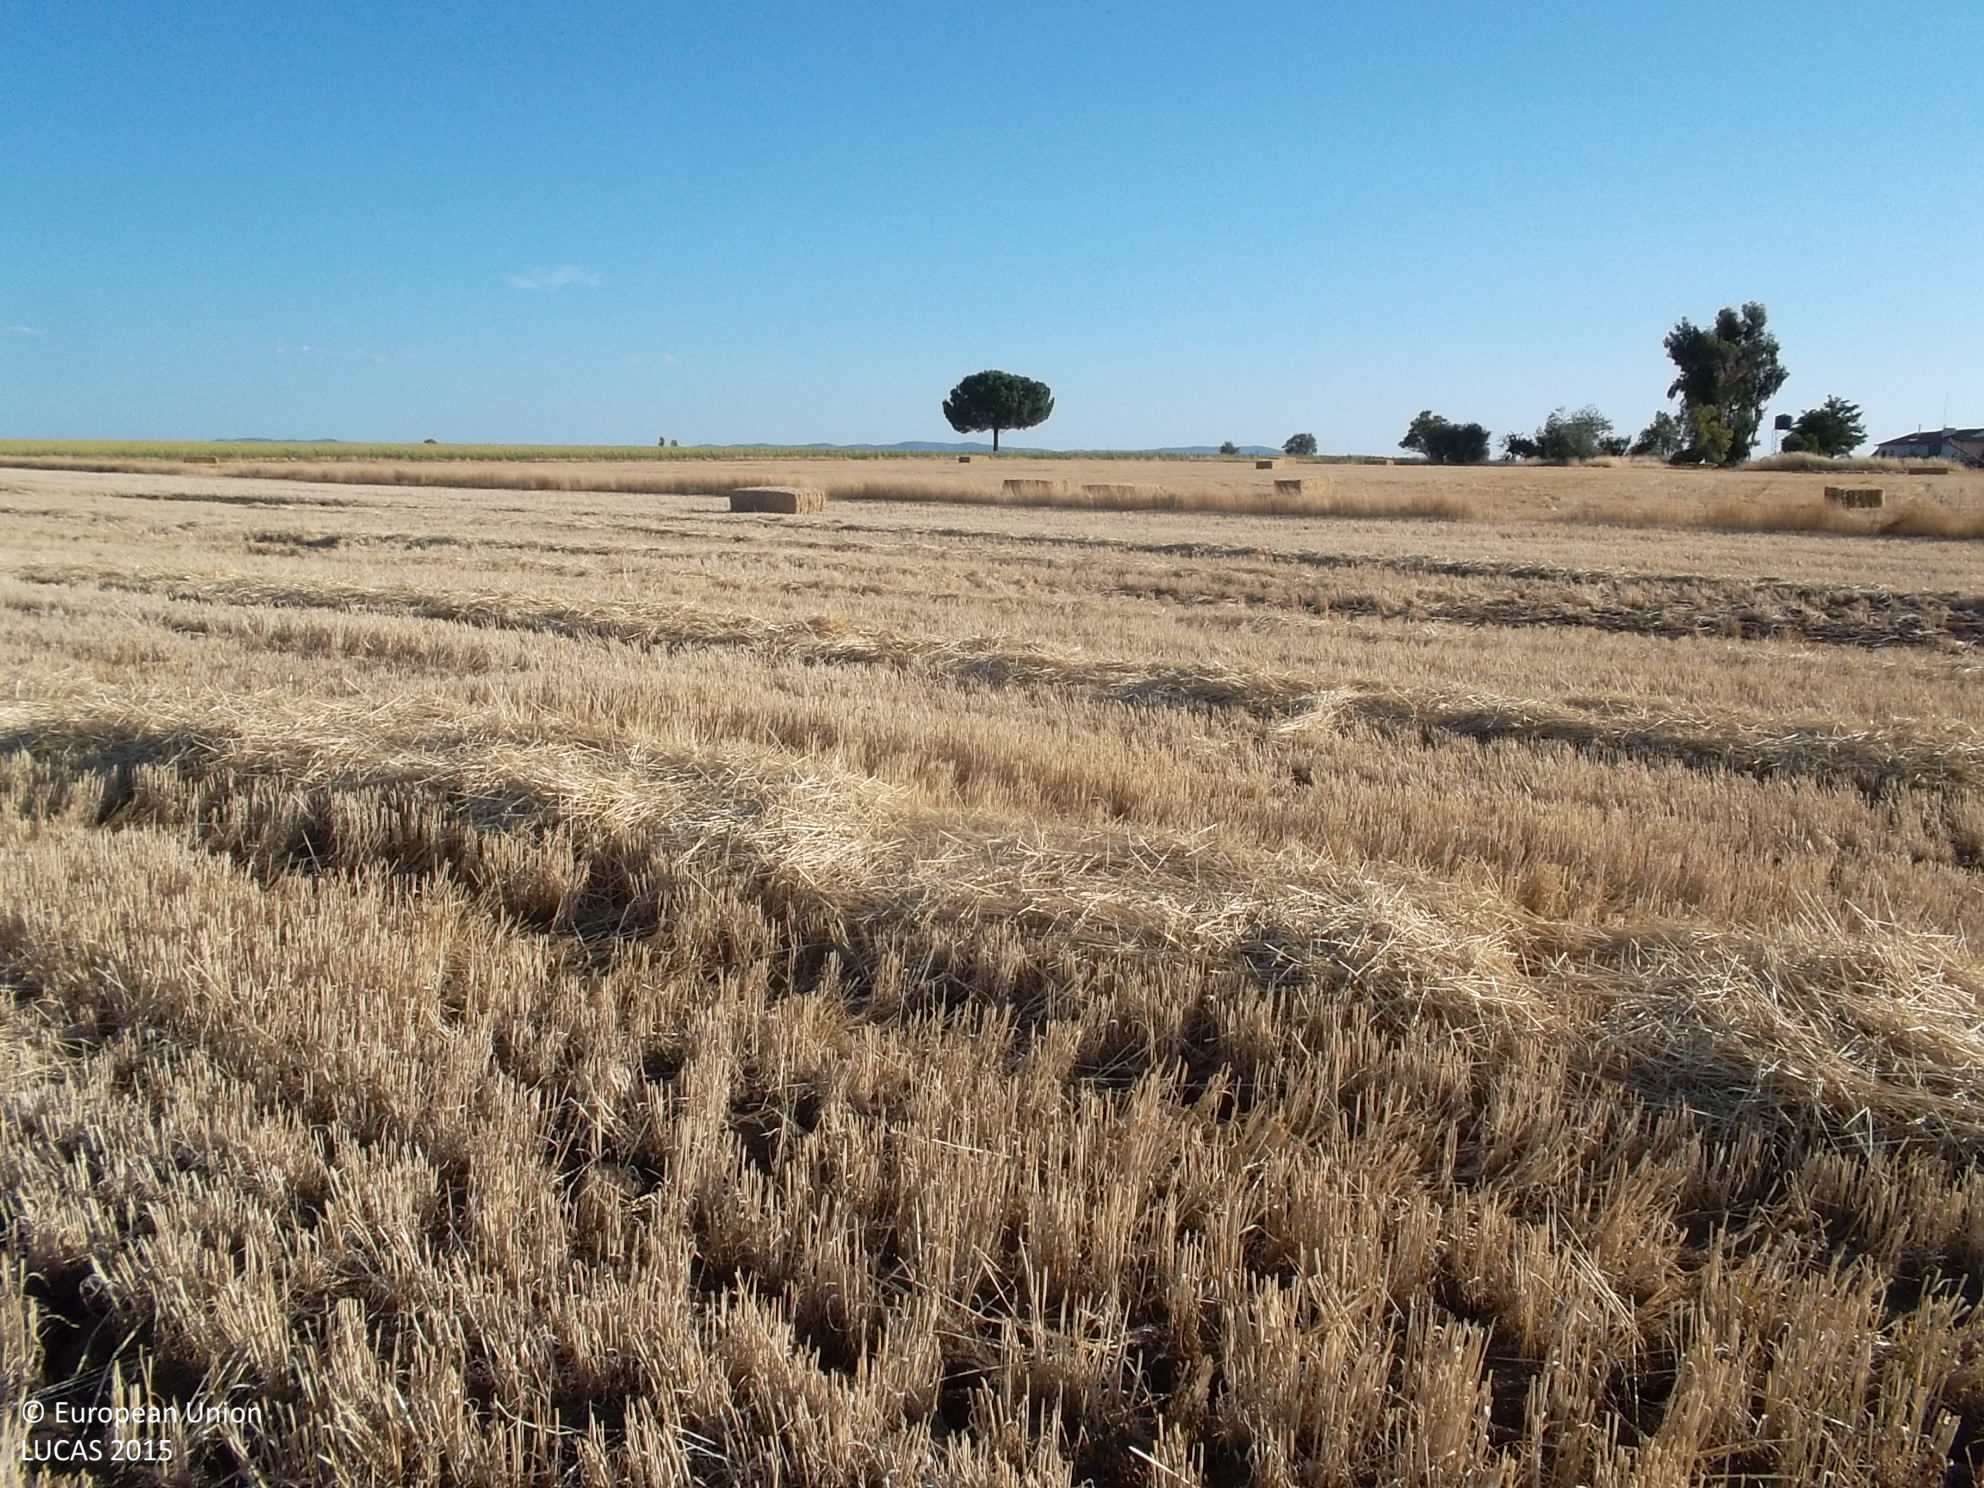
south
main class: Cropland
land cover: Barley
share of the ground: < 10 %
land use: Agriculture (excluding fallow land and kitchen gardens)
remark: Harvested field
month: July
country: ES
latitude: 38.3250
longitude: -5.7418
